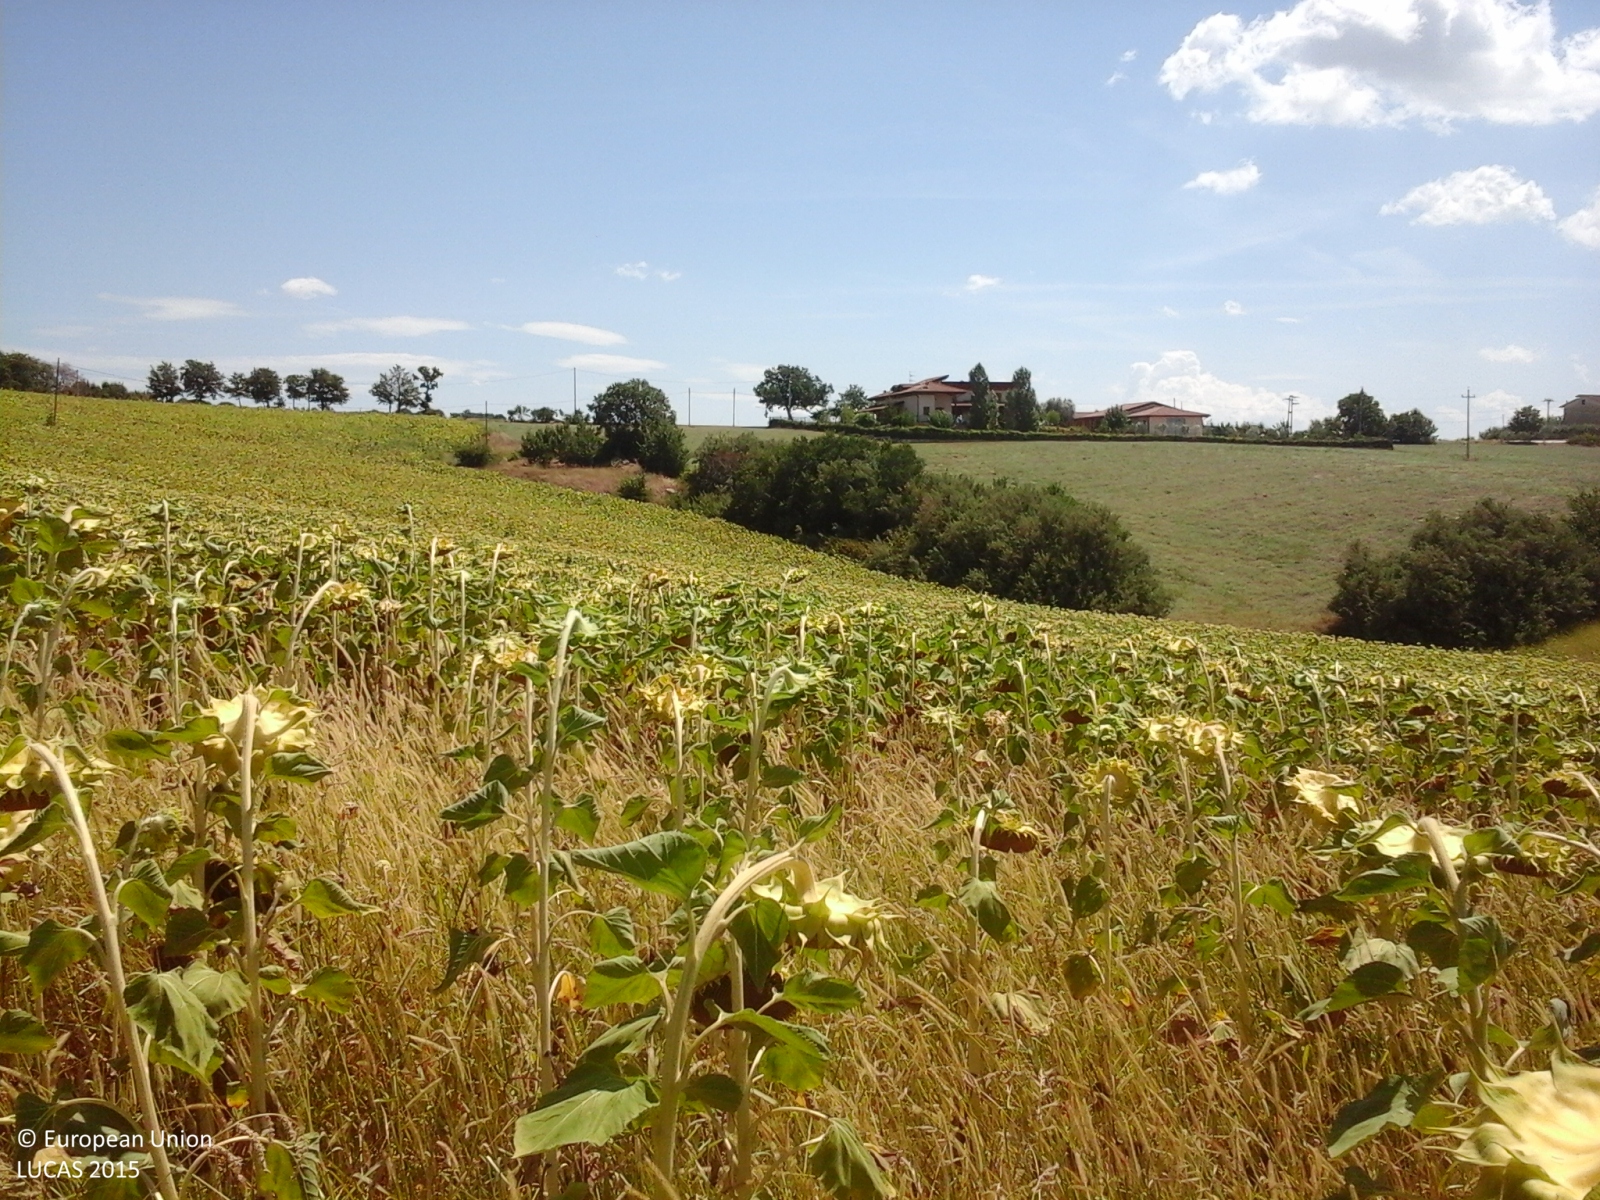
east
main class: Cropland
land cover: Sunflower
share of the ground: > 75 %
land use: Agriculture (excluding fallow land and kitchen gardens)
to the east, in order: Sunflower; Electric lines; Sunflower; Grassland with sparse tree/shrub cover; Sunflower
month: July
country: IT
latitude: 43.2498
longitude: 13.3291
